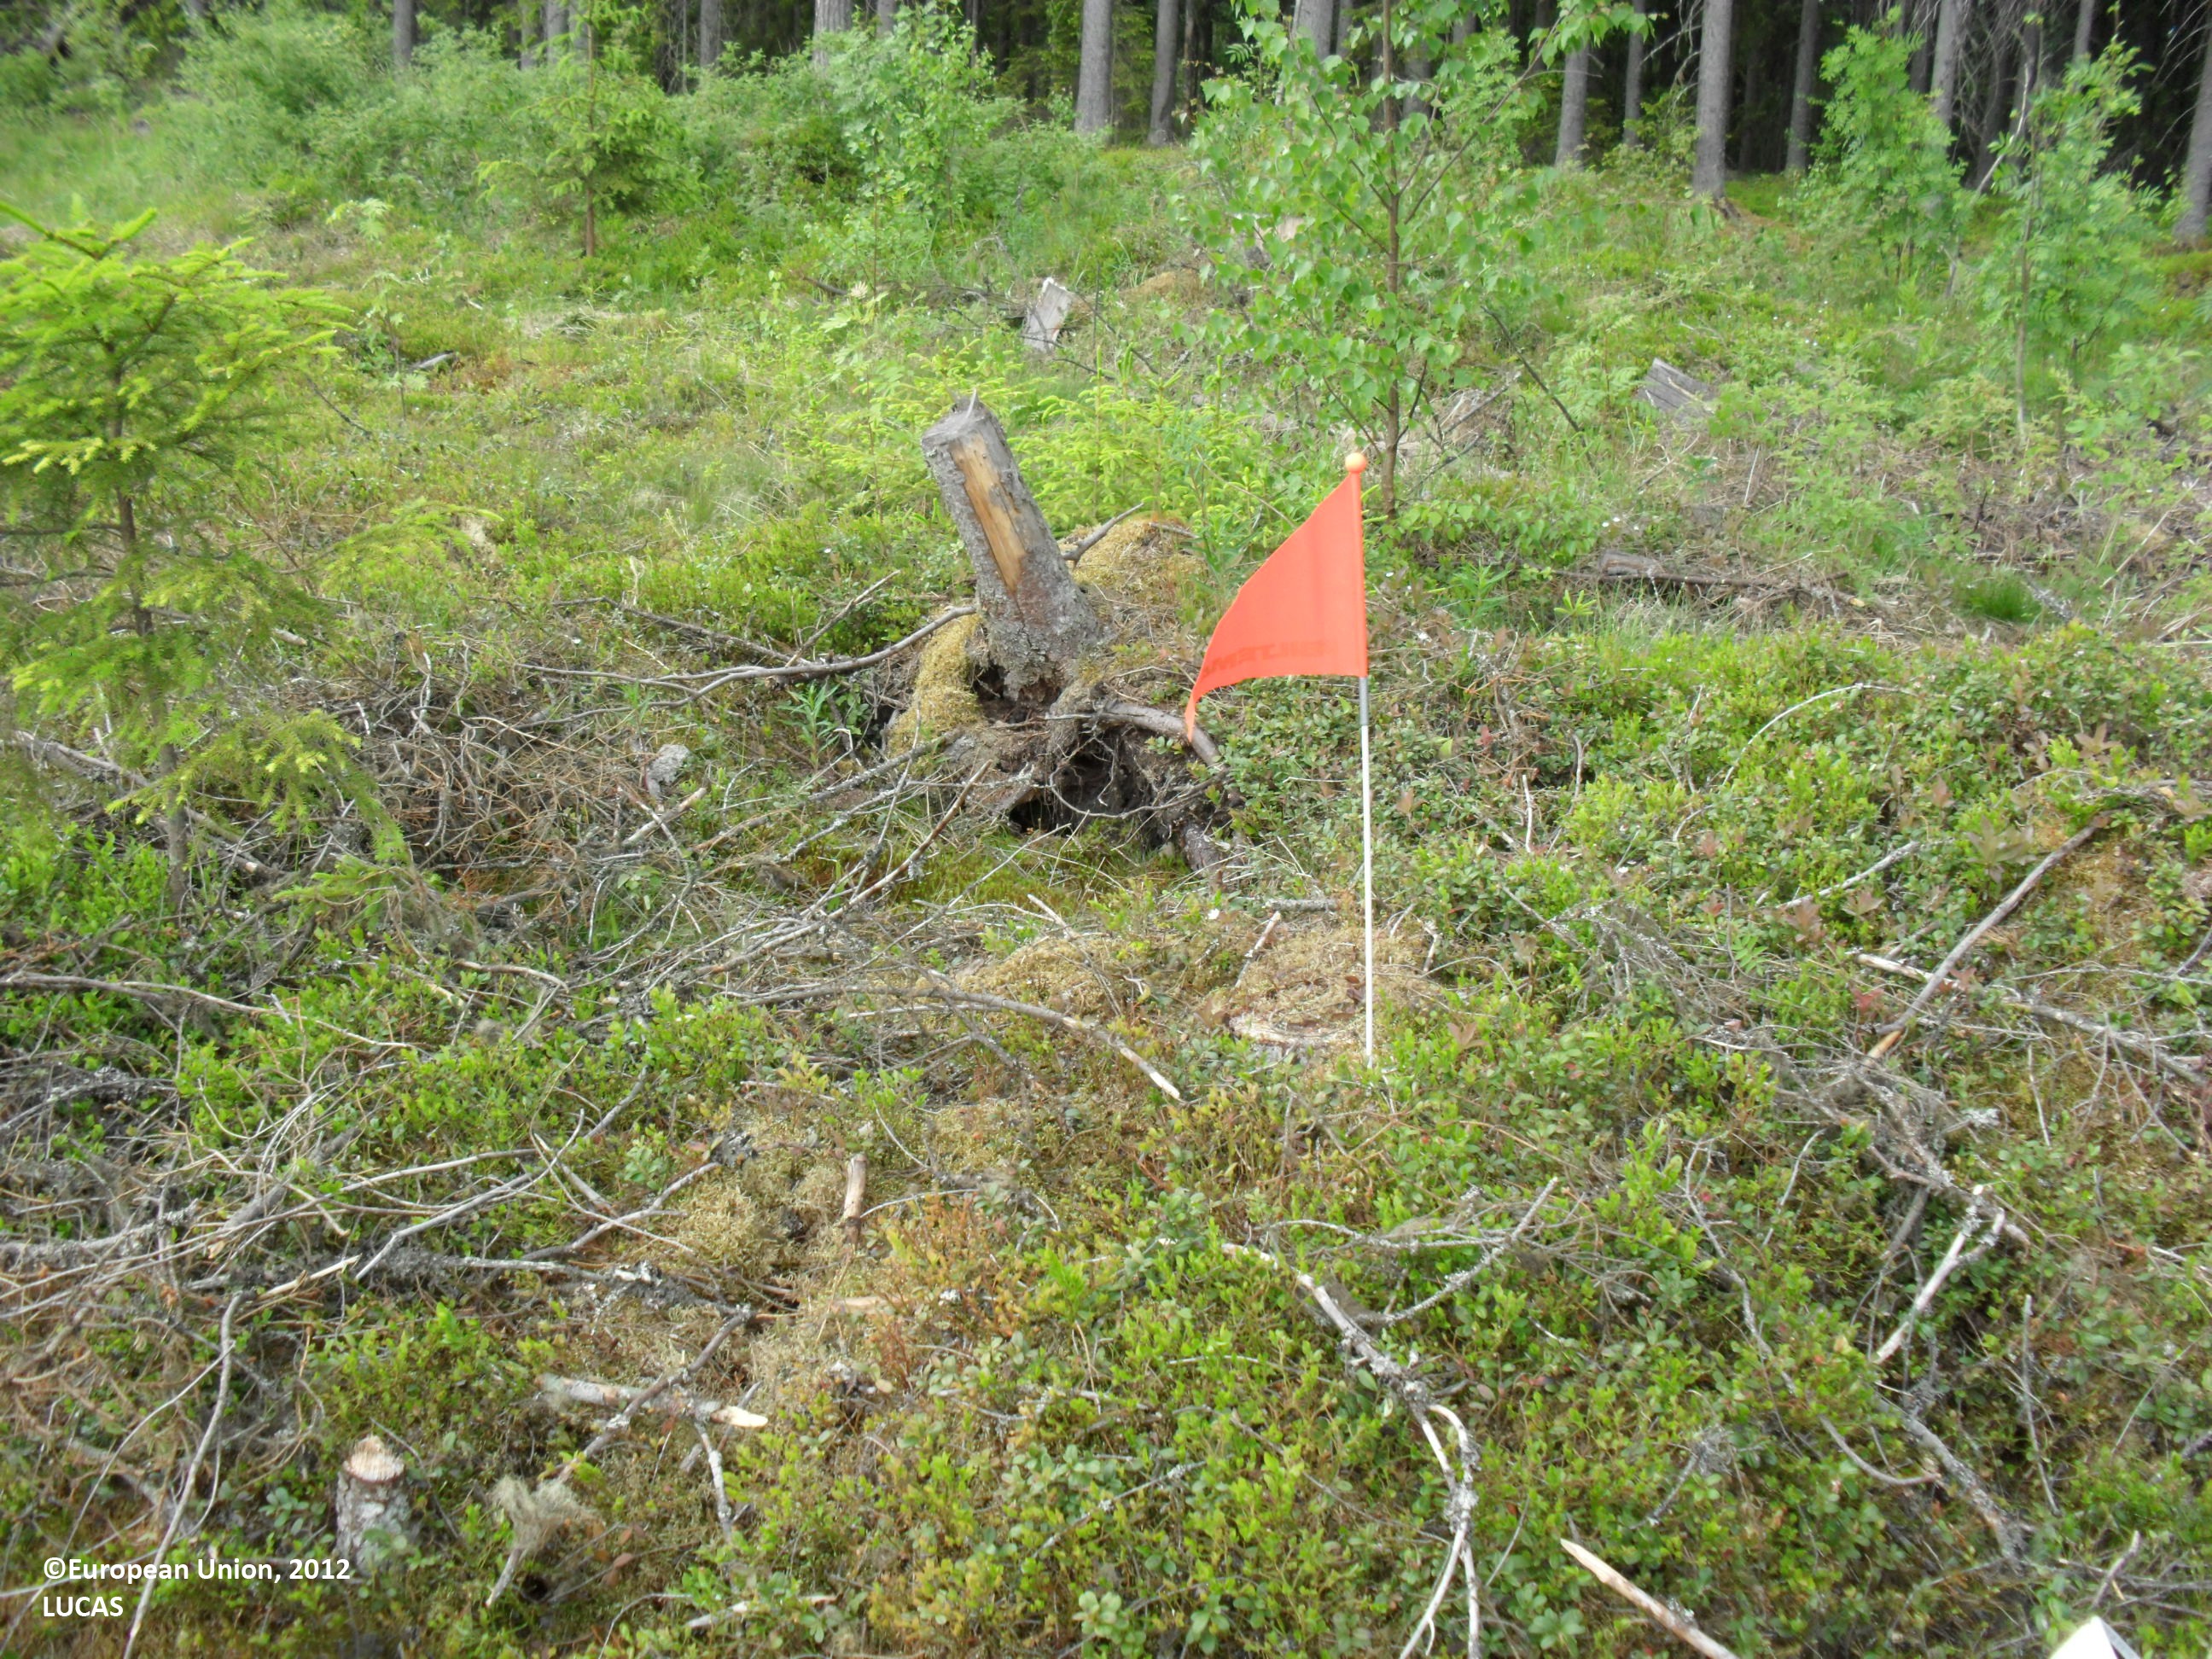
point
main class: Grassland
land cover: Grassland with sparse tree/shrub cover
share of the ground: < 10 %
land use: Forestry
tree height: < 5 m
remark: Clear cut
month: June
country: FI
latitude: 62.7934
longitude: 23.4582
